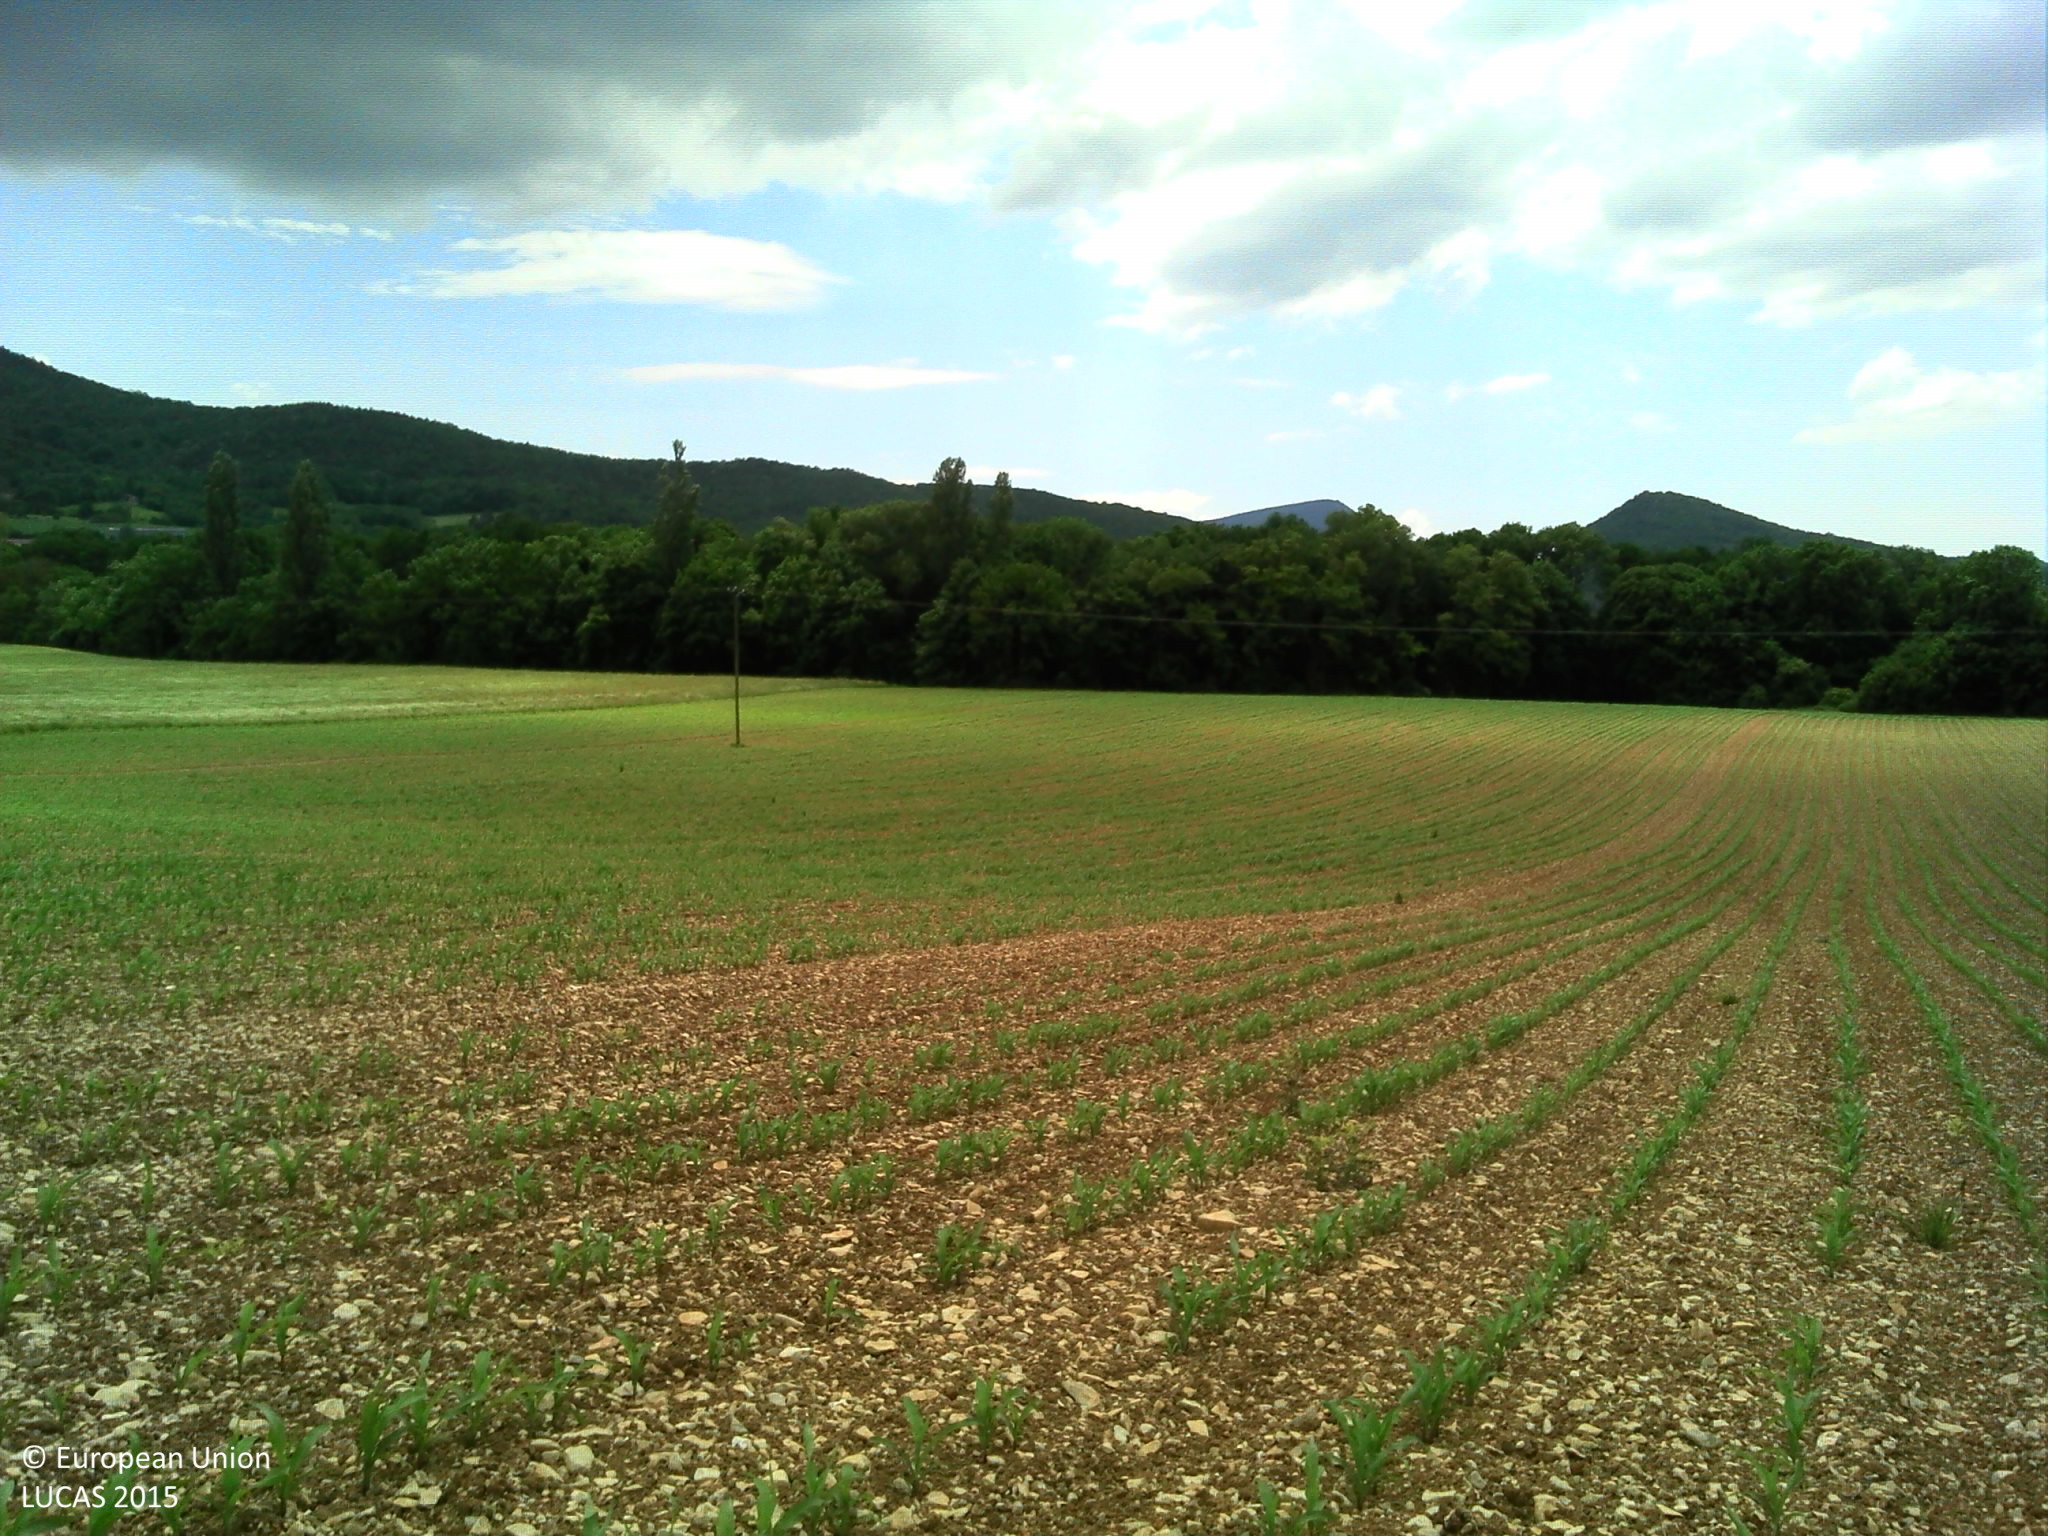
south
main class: Cropland
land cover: Maize
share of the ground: 50 - 75 %
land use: Agriculture (excluding fallow land and kitchen gardens)
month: May
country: FR
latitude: 44.9022
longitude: 5.0795
